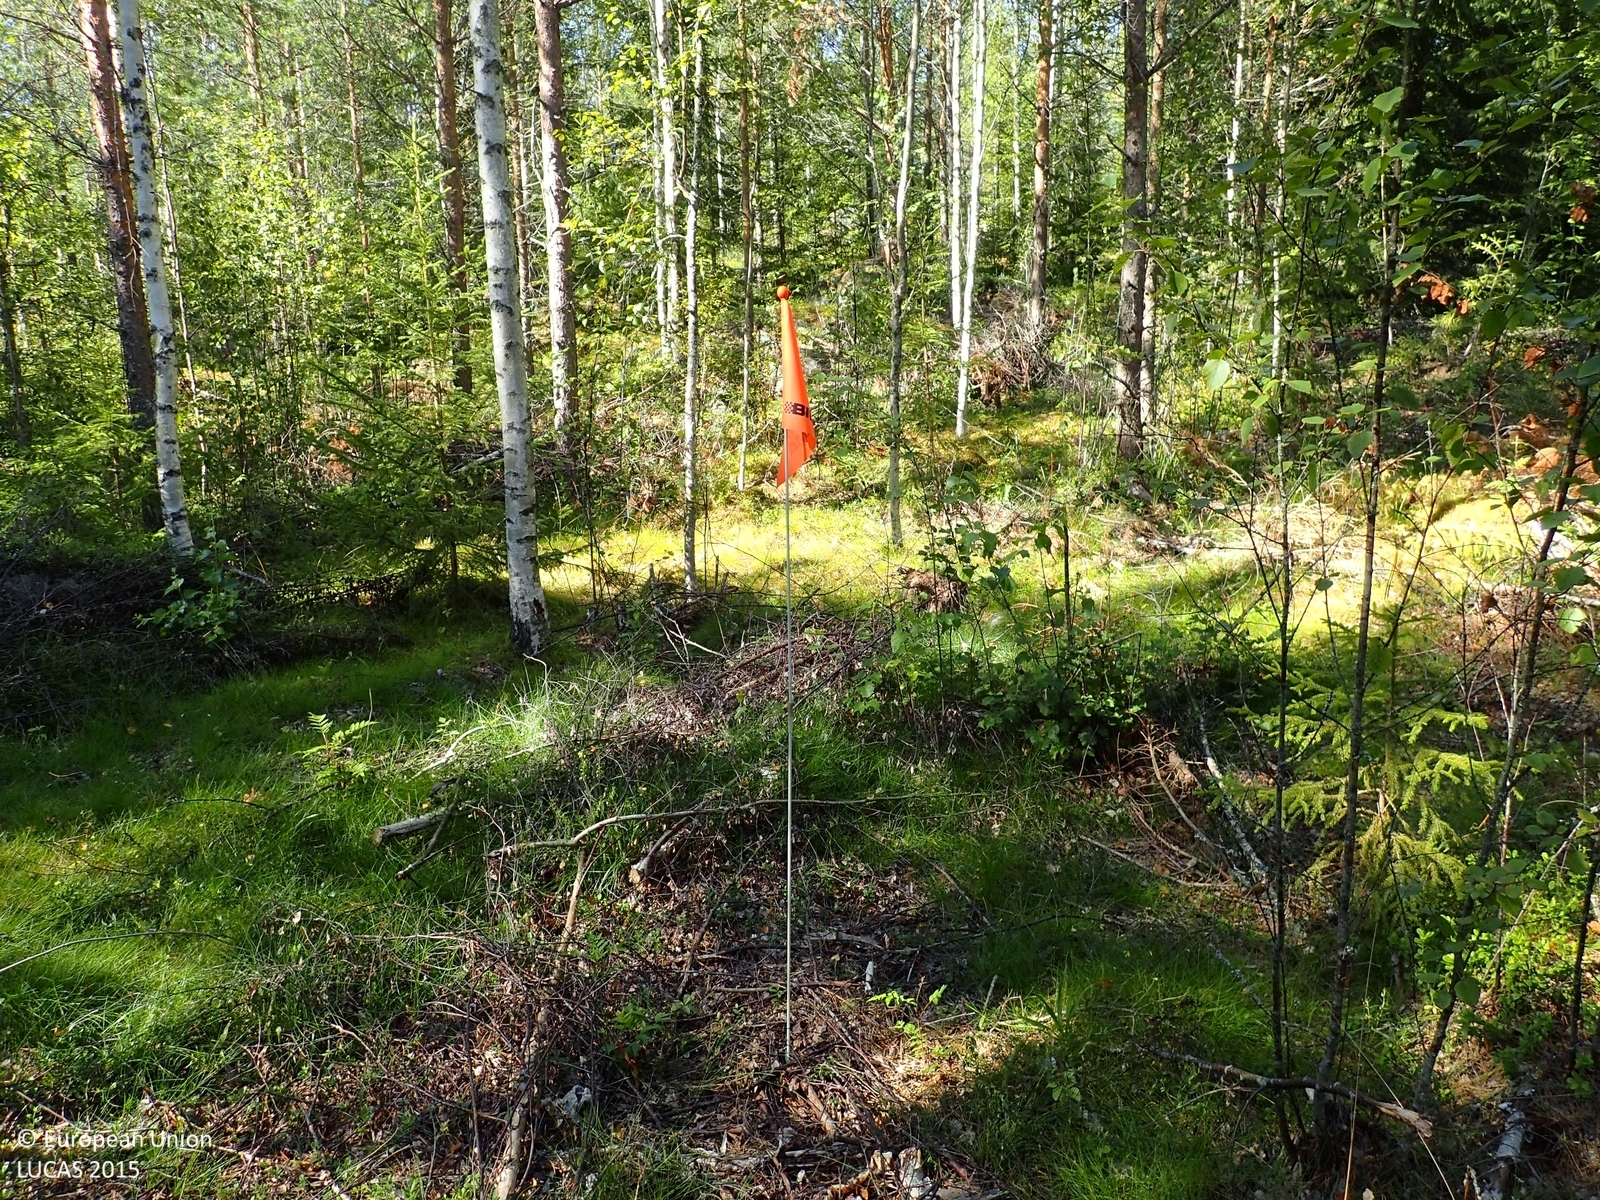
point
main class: Woodland
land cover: Pine dominated mixed woodland
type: boreal forest
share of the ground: > 75 %
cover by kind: broadleaved forest trees 40 %, coniferous forest trees 35 %, shrubs 10 %, herbaceous plants 10 %, lichens and mosses 5 %
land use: Forestry
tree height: > 5 m
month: August
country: FI
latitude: 62.5885
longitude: 22.6544
